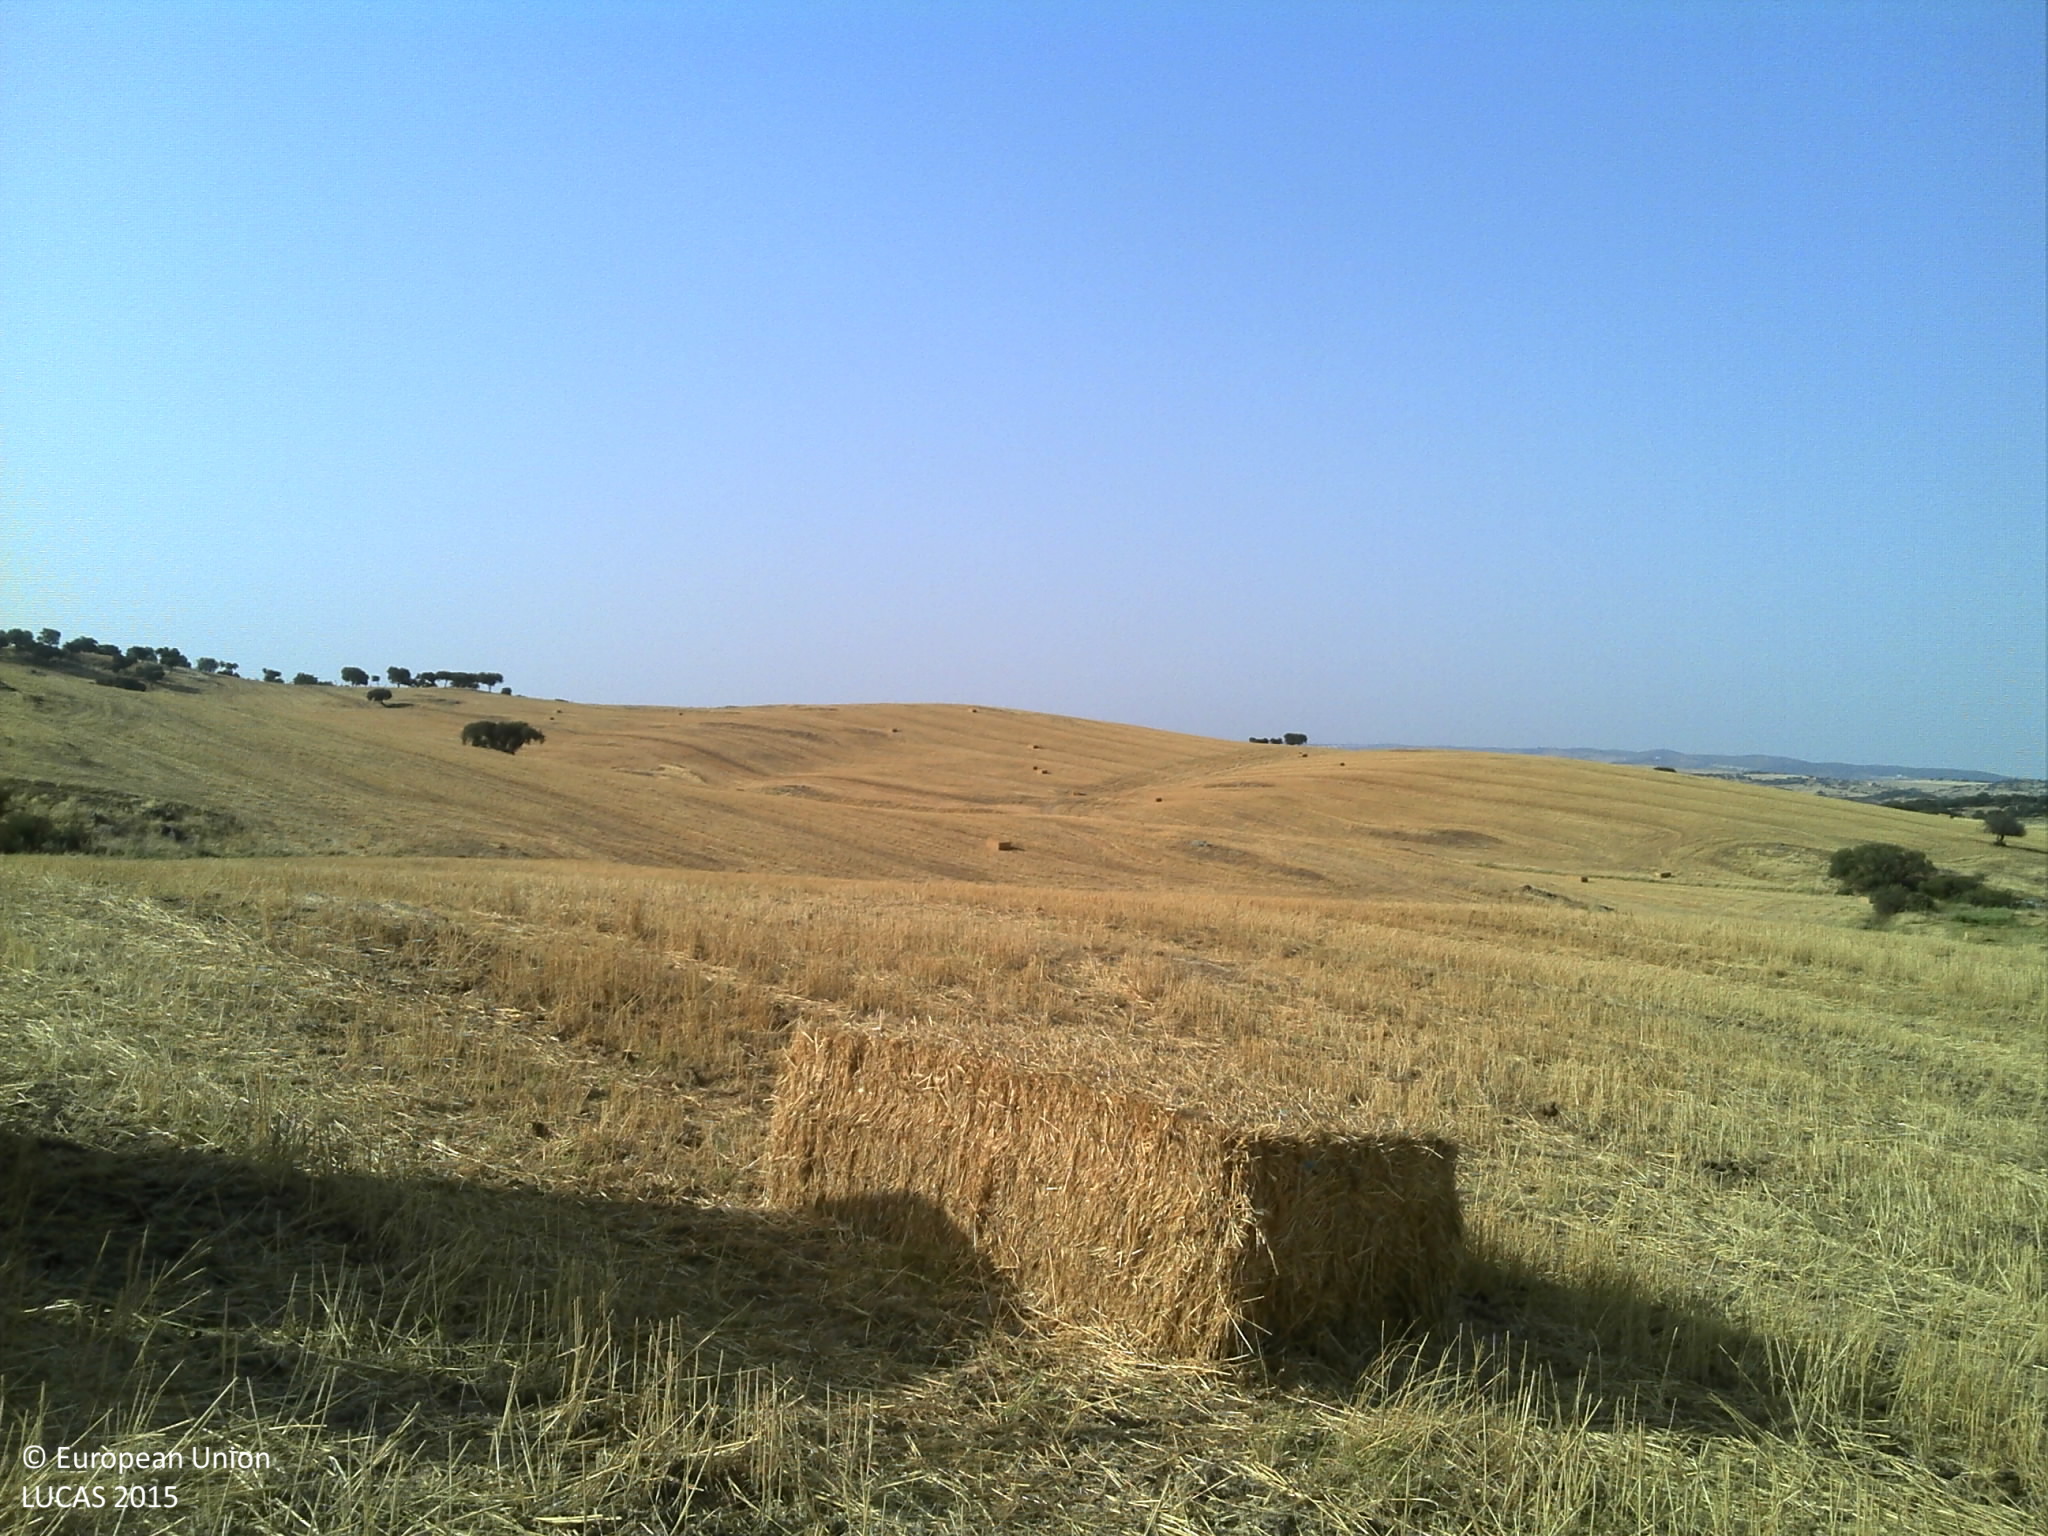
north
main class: Cropland
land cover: Triticale
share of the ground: < 10 %
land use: Agriculture (excluding fallow land and kitchen gardens)
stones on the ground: < 10 %
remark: Harvested field
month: July
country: PT
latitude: 38.7282
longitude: -7.3409
